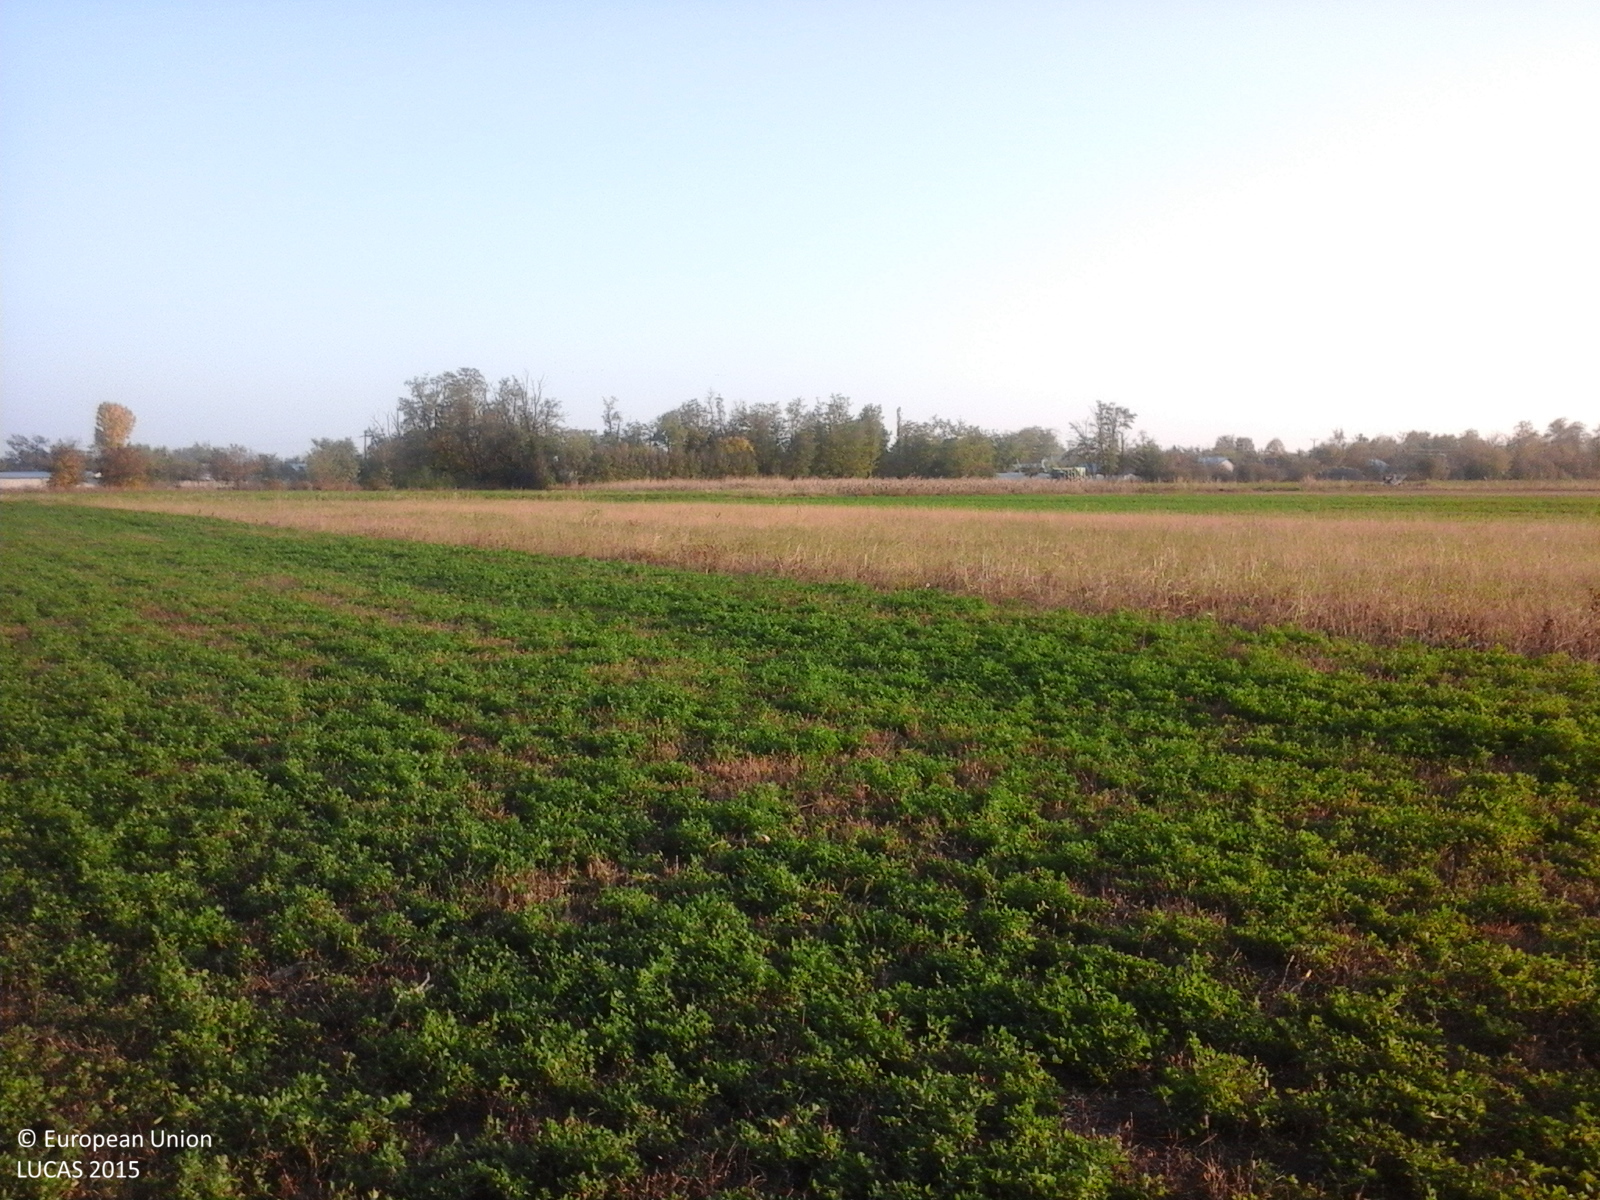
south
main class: Cropland
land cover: Lucerne
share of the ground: > 75 %
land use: Agriculture (excluding fallow land and kitchen gardens)
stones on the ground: < 10 %
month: October
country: RO
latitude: 45.1318
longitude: 26.9563
